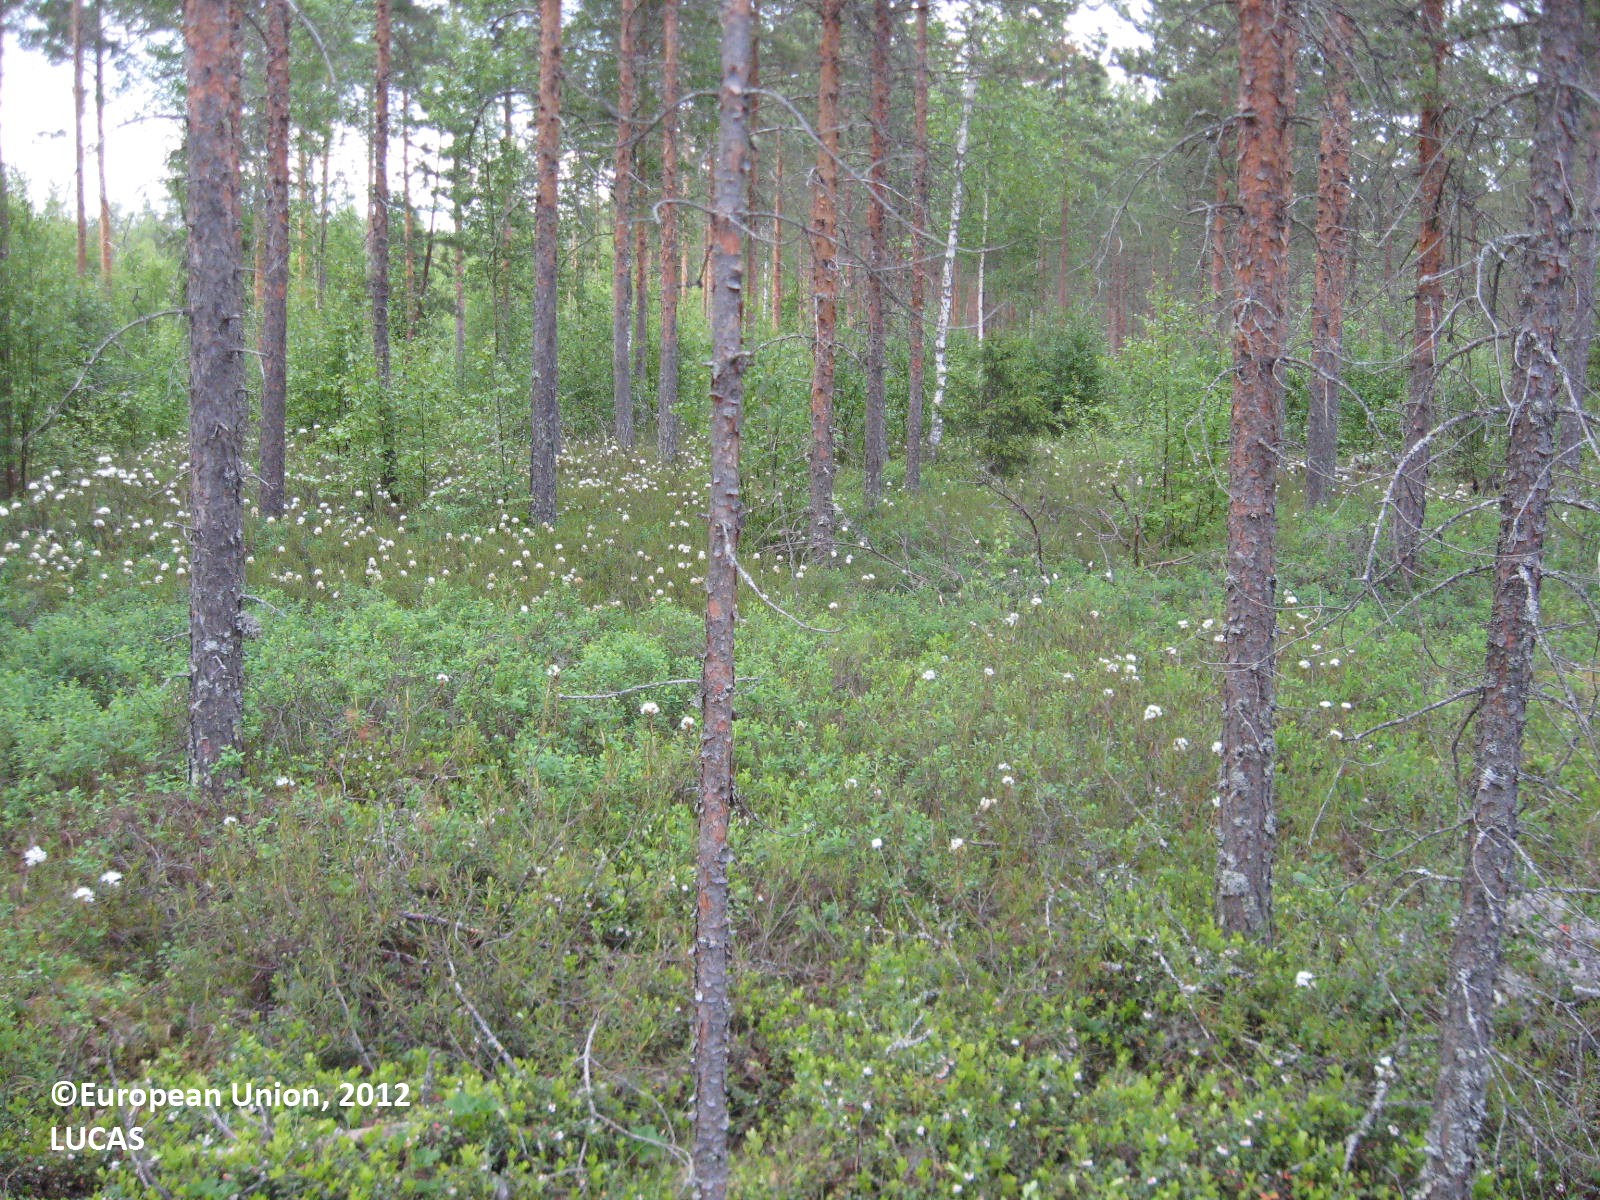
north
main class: Woodland
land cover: Pine dominated coniferous woodland
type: boreal forest
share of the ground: > 75 %
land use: Forestry
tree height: > 5 m
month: June
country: FI
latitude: 63.0081
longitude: 22.6736
